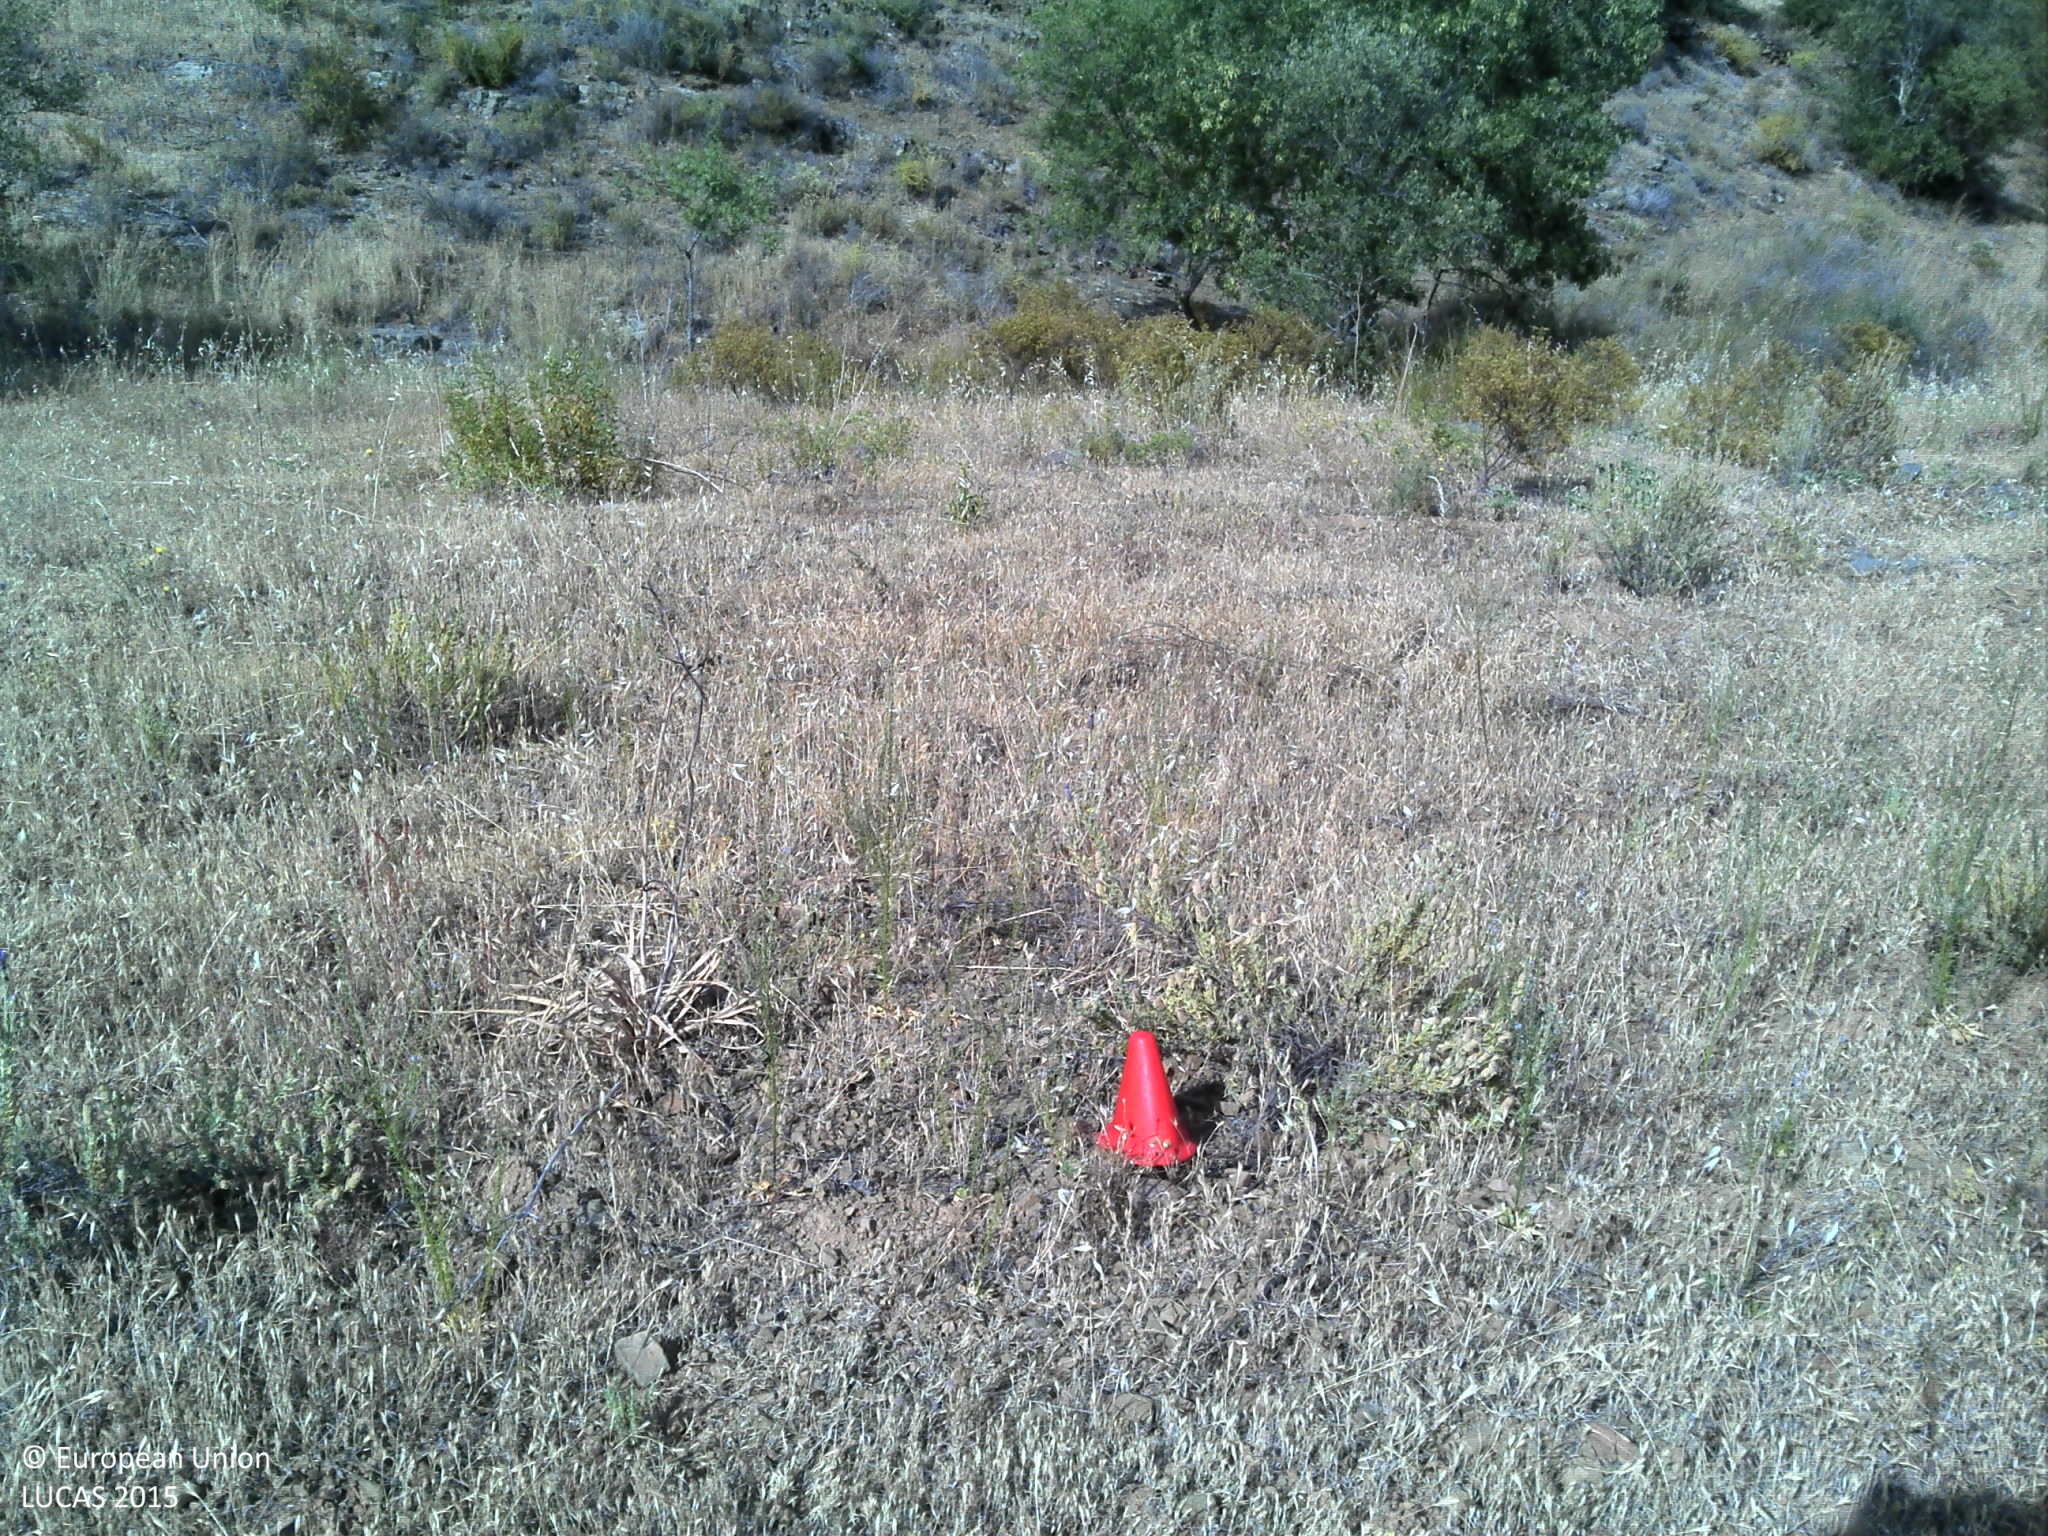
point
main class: Grassland
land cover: Grassland with sparse tree/shrub cover
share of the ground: 50 - 75 %
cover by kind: herbaceous plants 70 %, unconsolidated bare surface 25 %, broadleaved forest trees 5 %
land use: Agriculture (excluding fallow land and kitchen gardens)
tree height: > 5 m
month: May
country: PT
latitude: 37.2852
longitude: -7.4529
